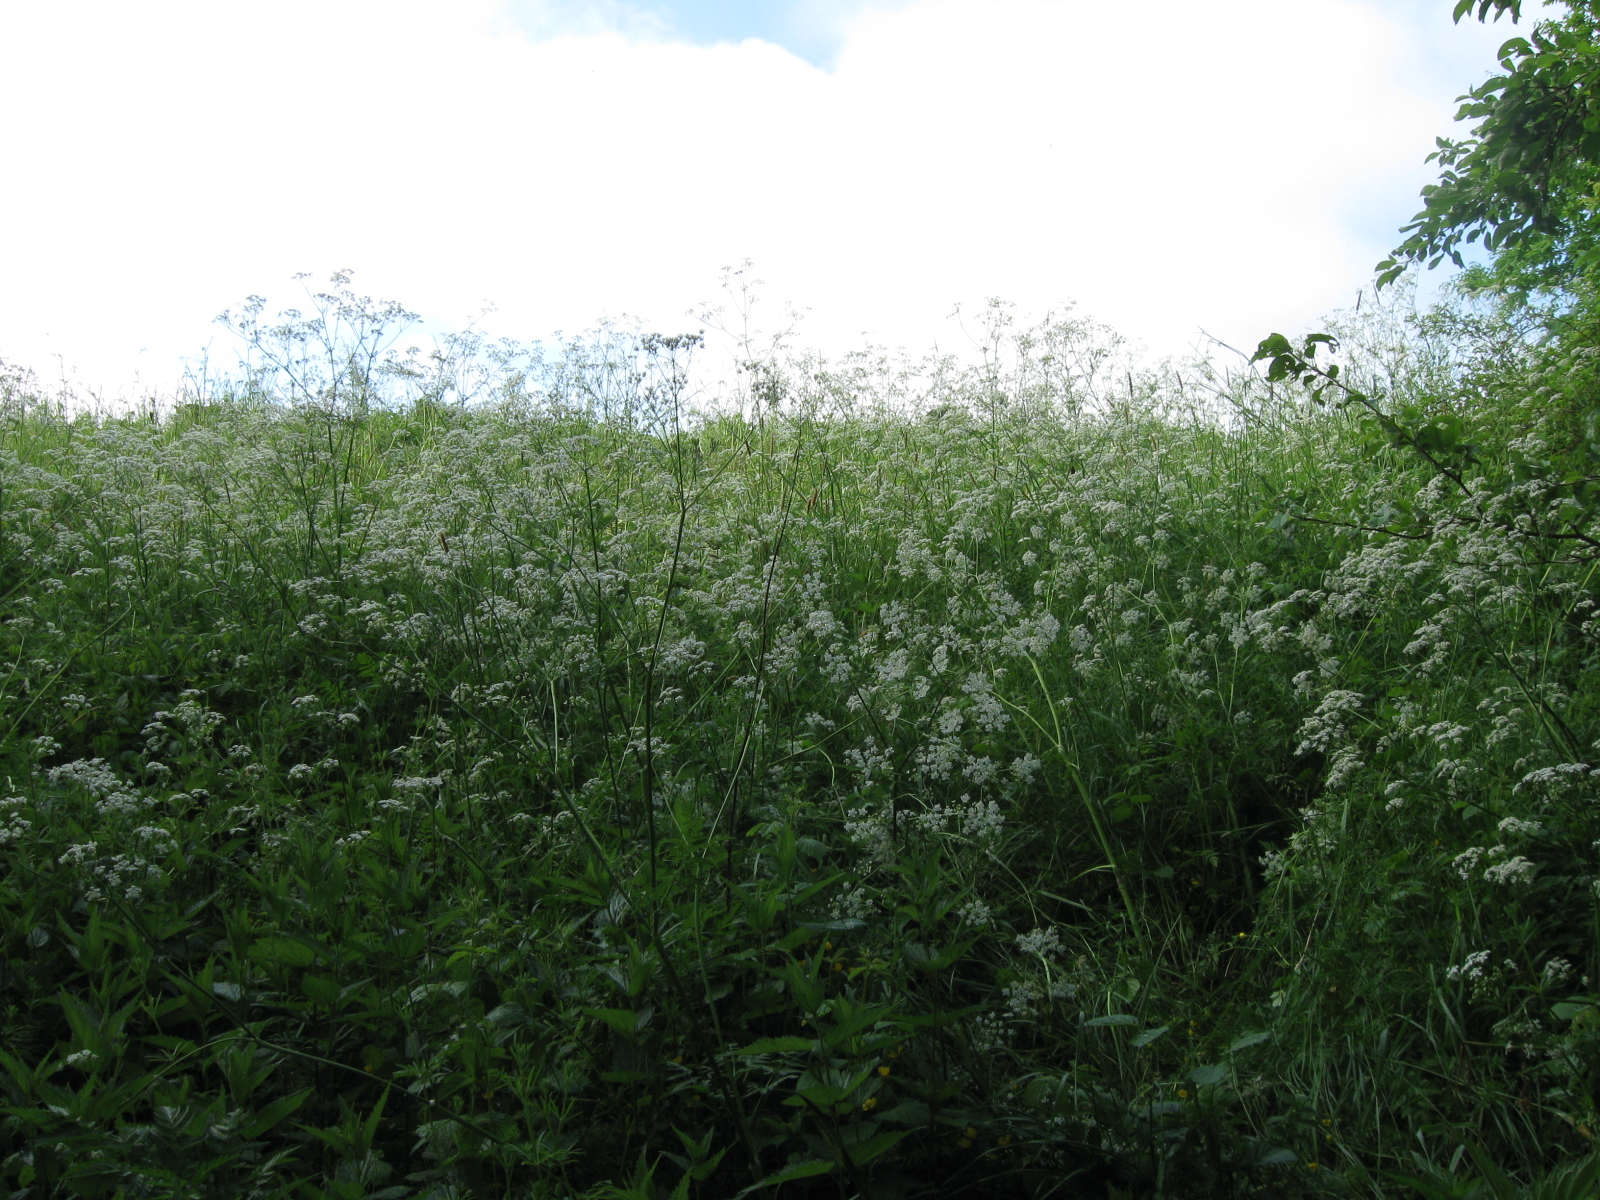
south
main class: Woodland
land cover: Broadleaved woodland
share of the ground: 50 - 75 %
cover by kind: broadleaved forest trees 65 %, herbaceous plants 35 %
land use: Semi-natural and natural areas not in use
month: June
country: LT
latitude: 54.5496
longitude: 23.8957
